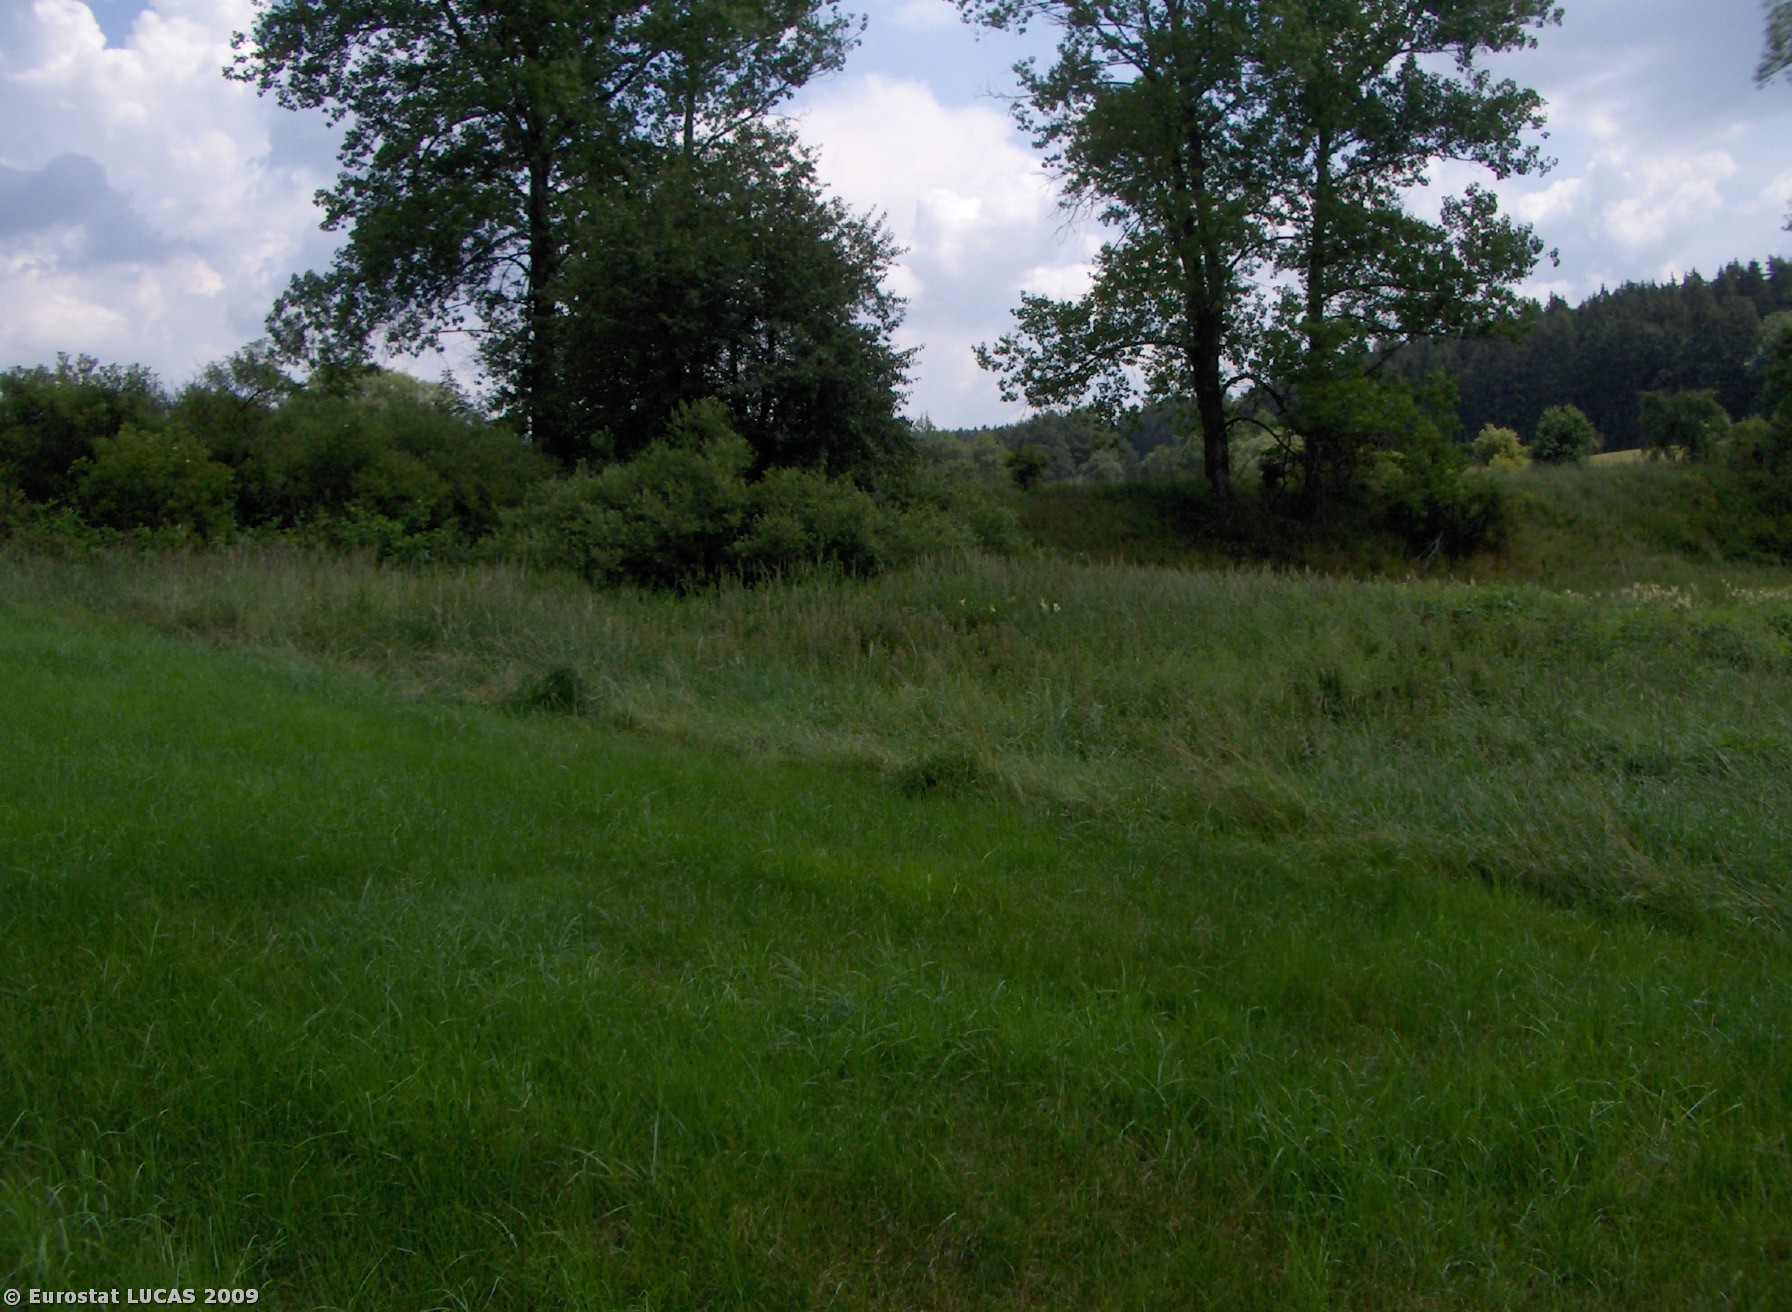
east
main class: Grassland
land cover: Grassland without tree/shrub cover
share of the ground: > 75 %
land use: Agriculture (excluding fallow land and kitchen gardens)
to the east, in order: Grassland without tree/shrub cover; Spontaneously vegetated surfaces; Broadleaved woodland; Spontaneously vegetated surfaces; Inland water bodies
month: July
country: CZ
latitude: 49.5816
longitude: 13.1949
